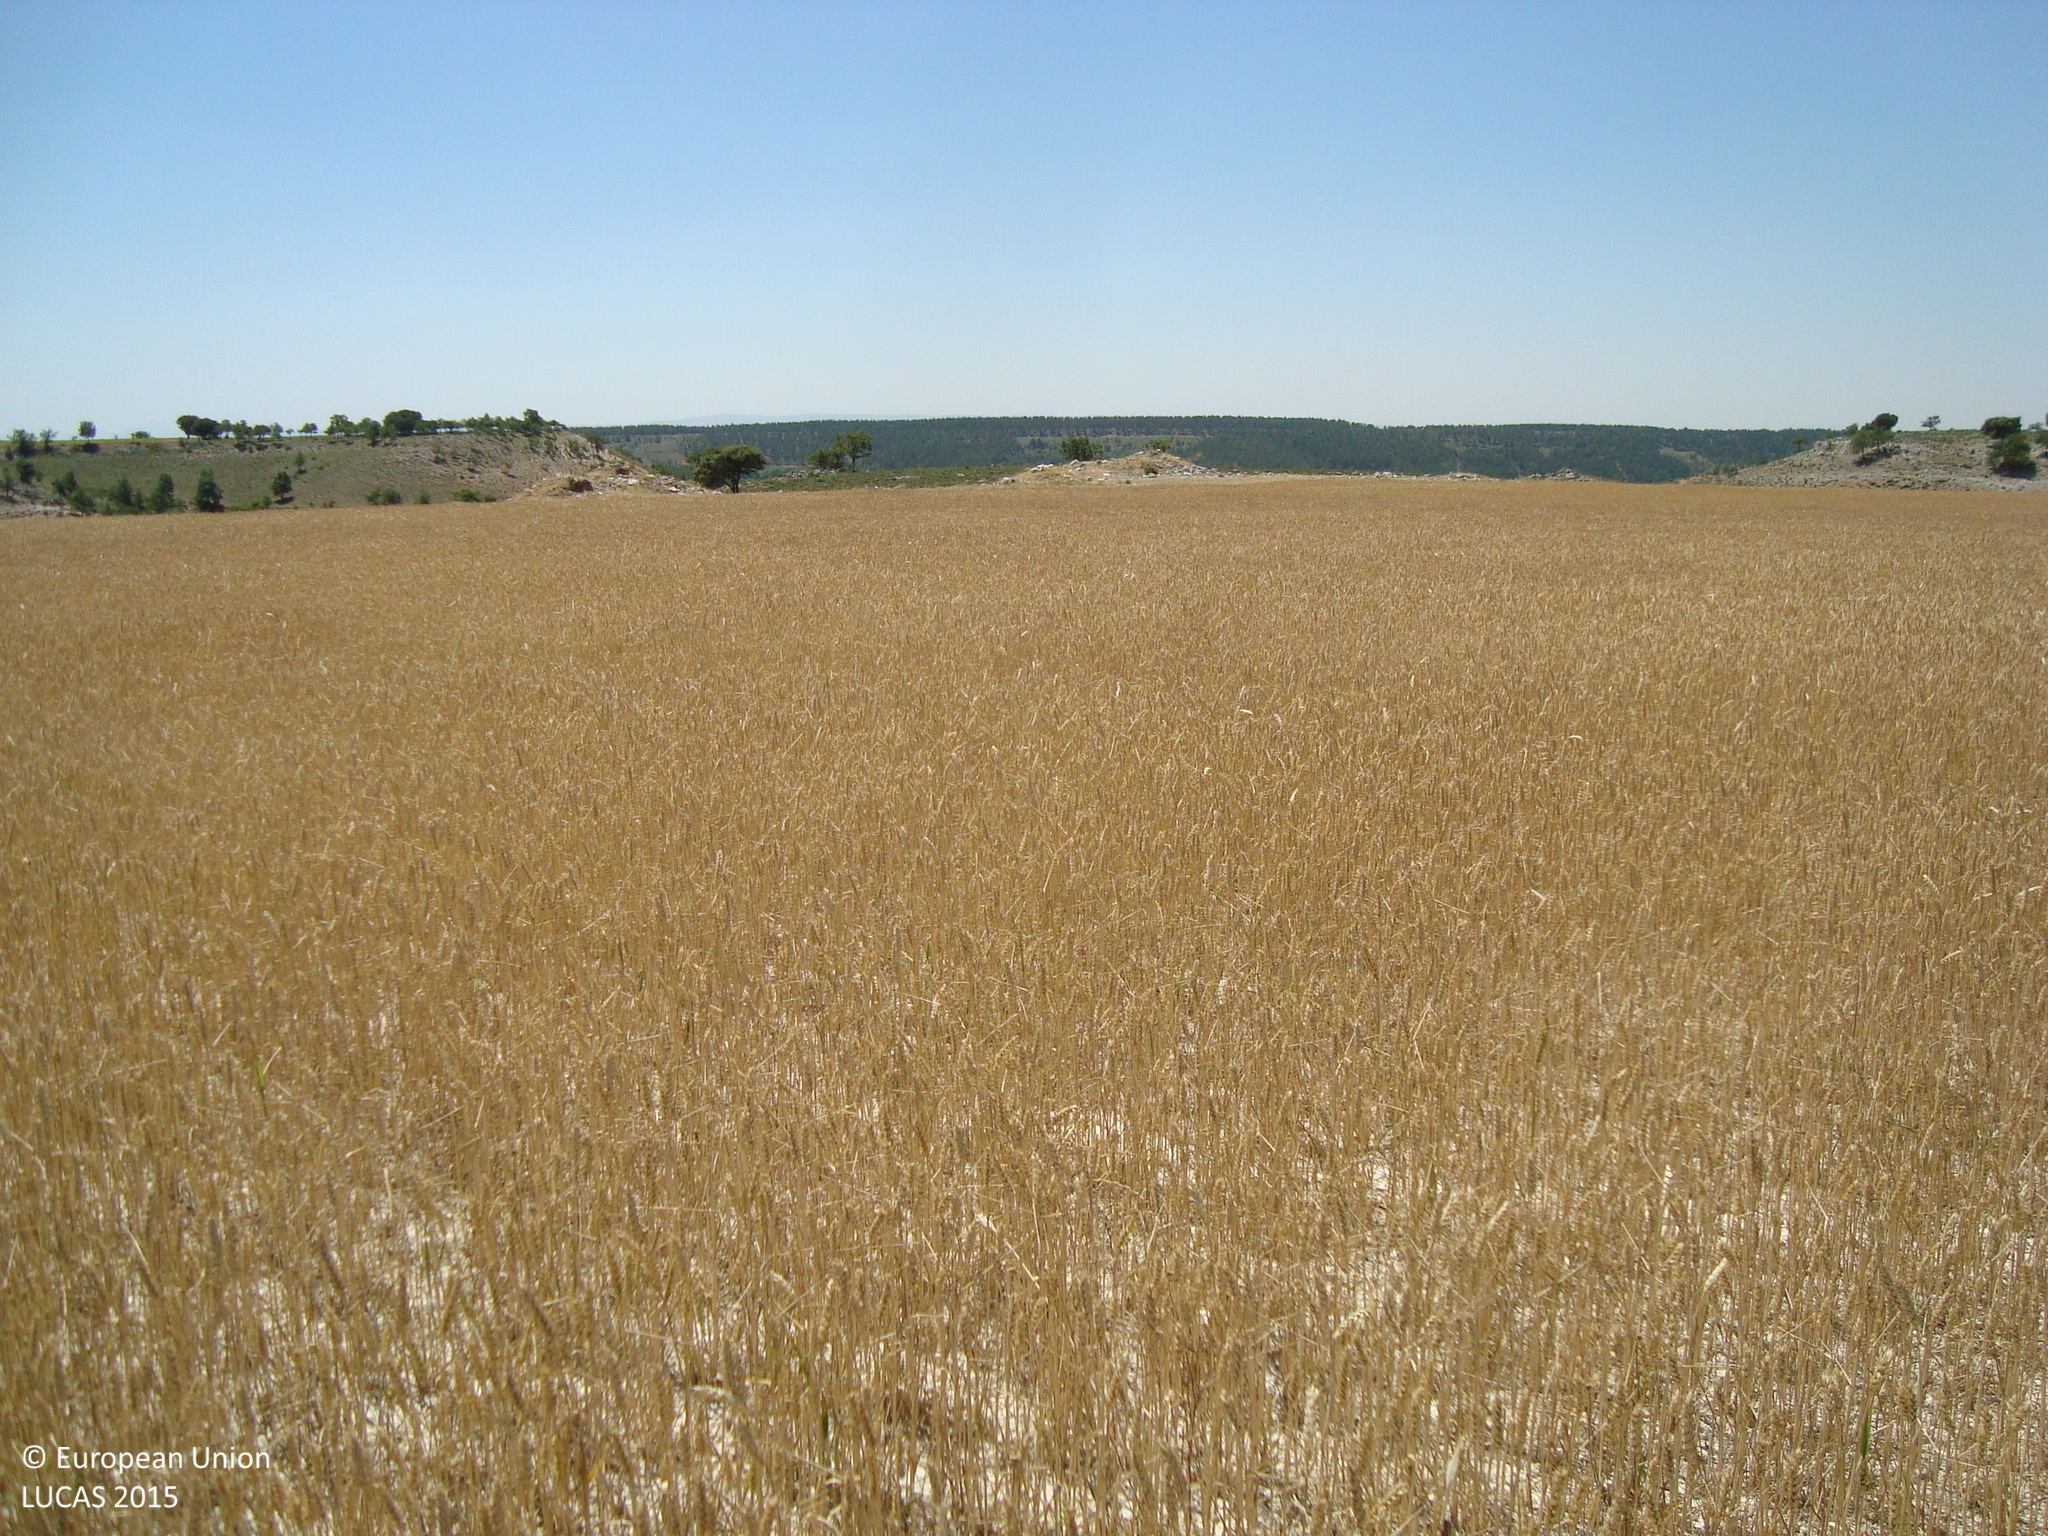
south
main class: Cropland
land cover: Common wheat
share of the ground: 50 - 75 %
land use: Agriculture (excluding fallow land and kitchen gardens)
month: June
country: ES
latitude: 41.7798
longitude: -3.7833
